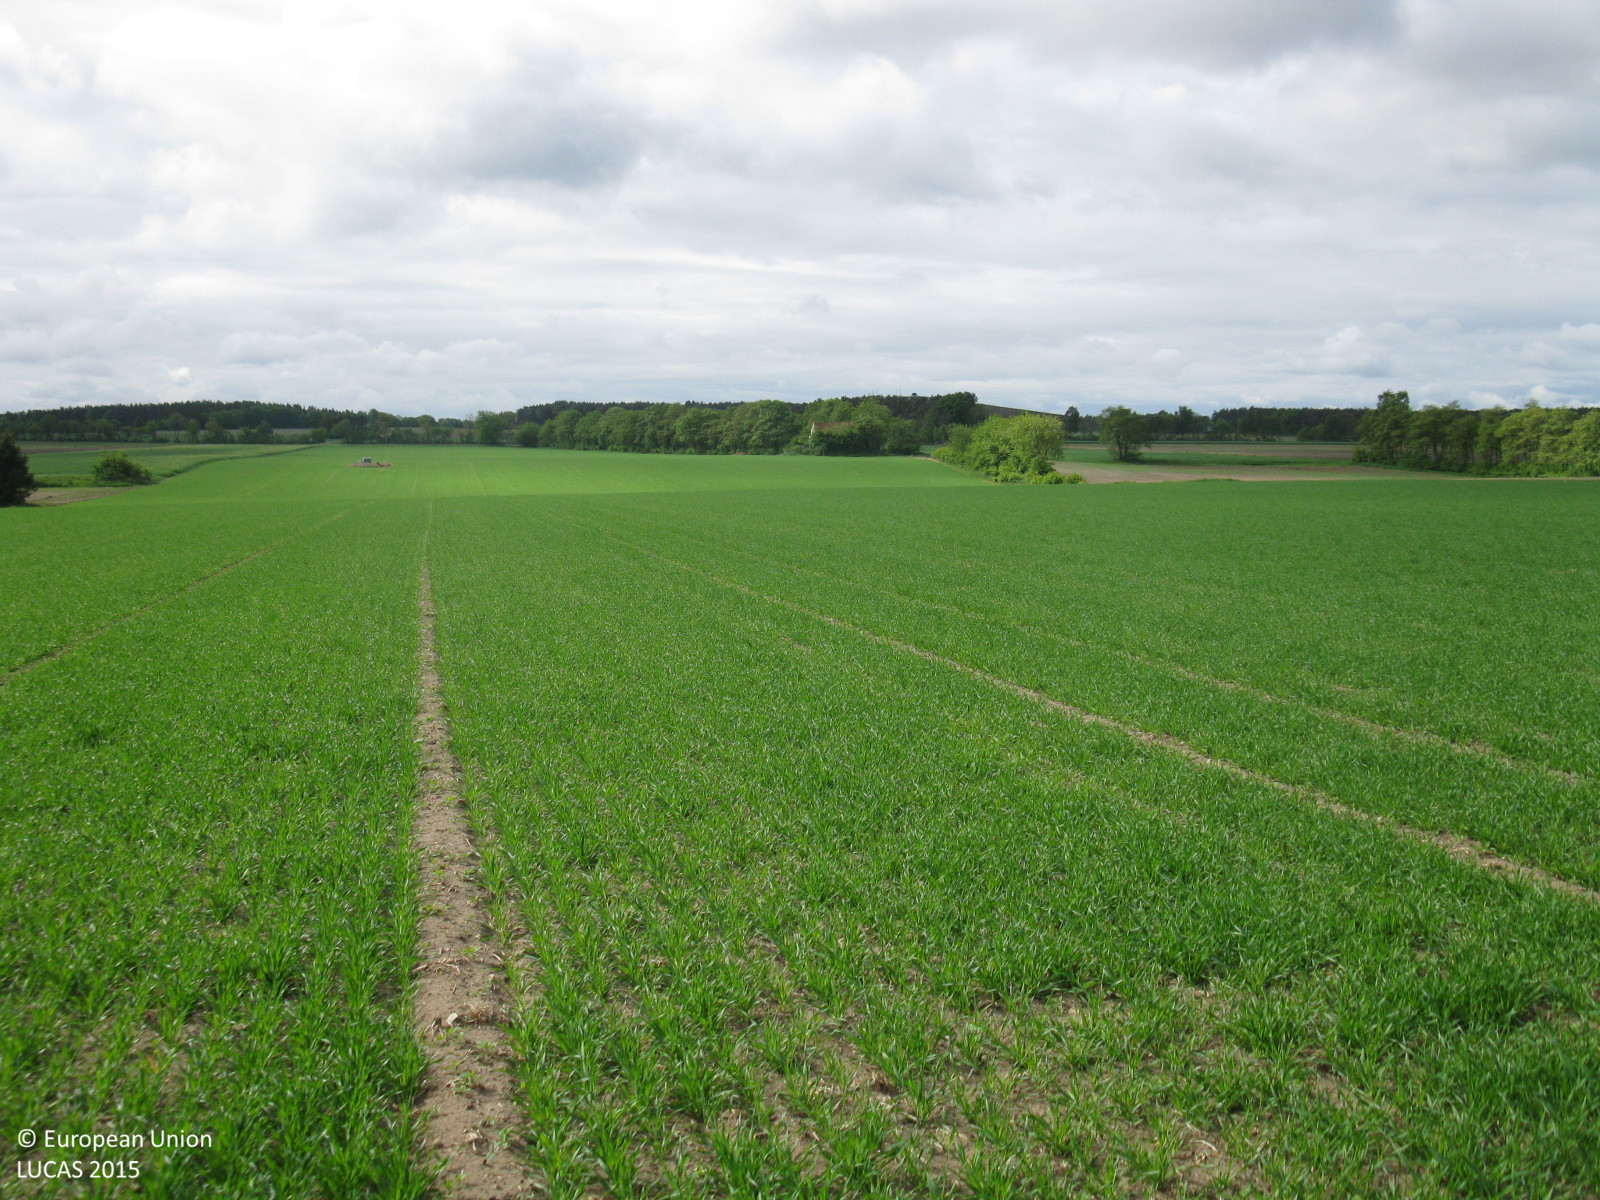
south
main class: Cropland
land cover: Barley
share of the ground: > 75 %
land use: Agriculture (excluding fallow land and kitchen gardens)
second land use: Community services
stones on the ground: < 10 %
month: May
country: DE
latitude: 52.8173
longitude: 7.4335
